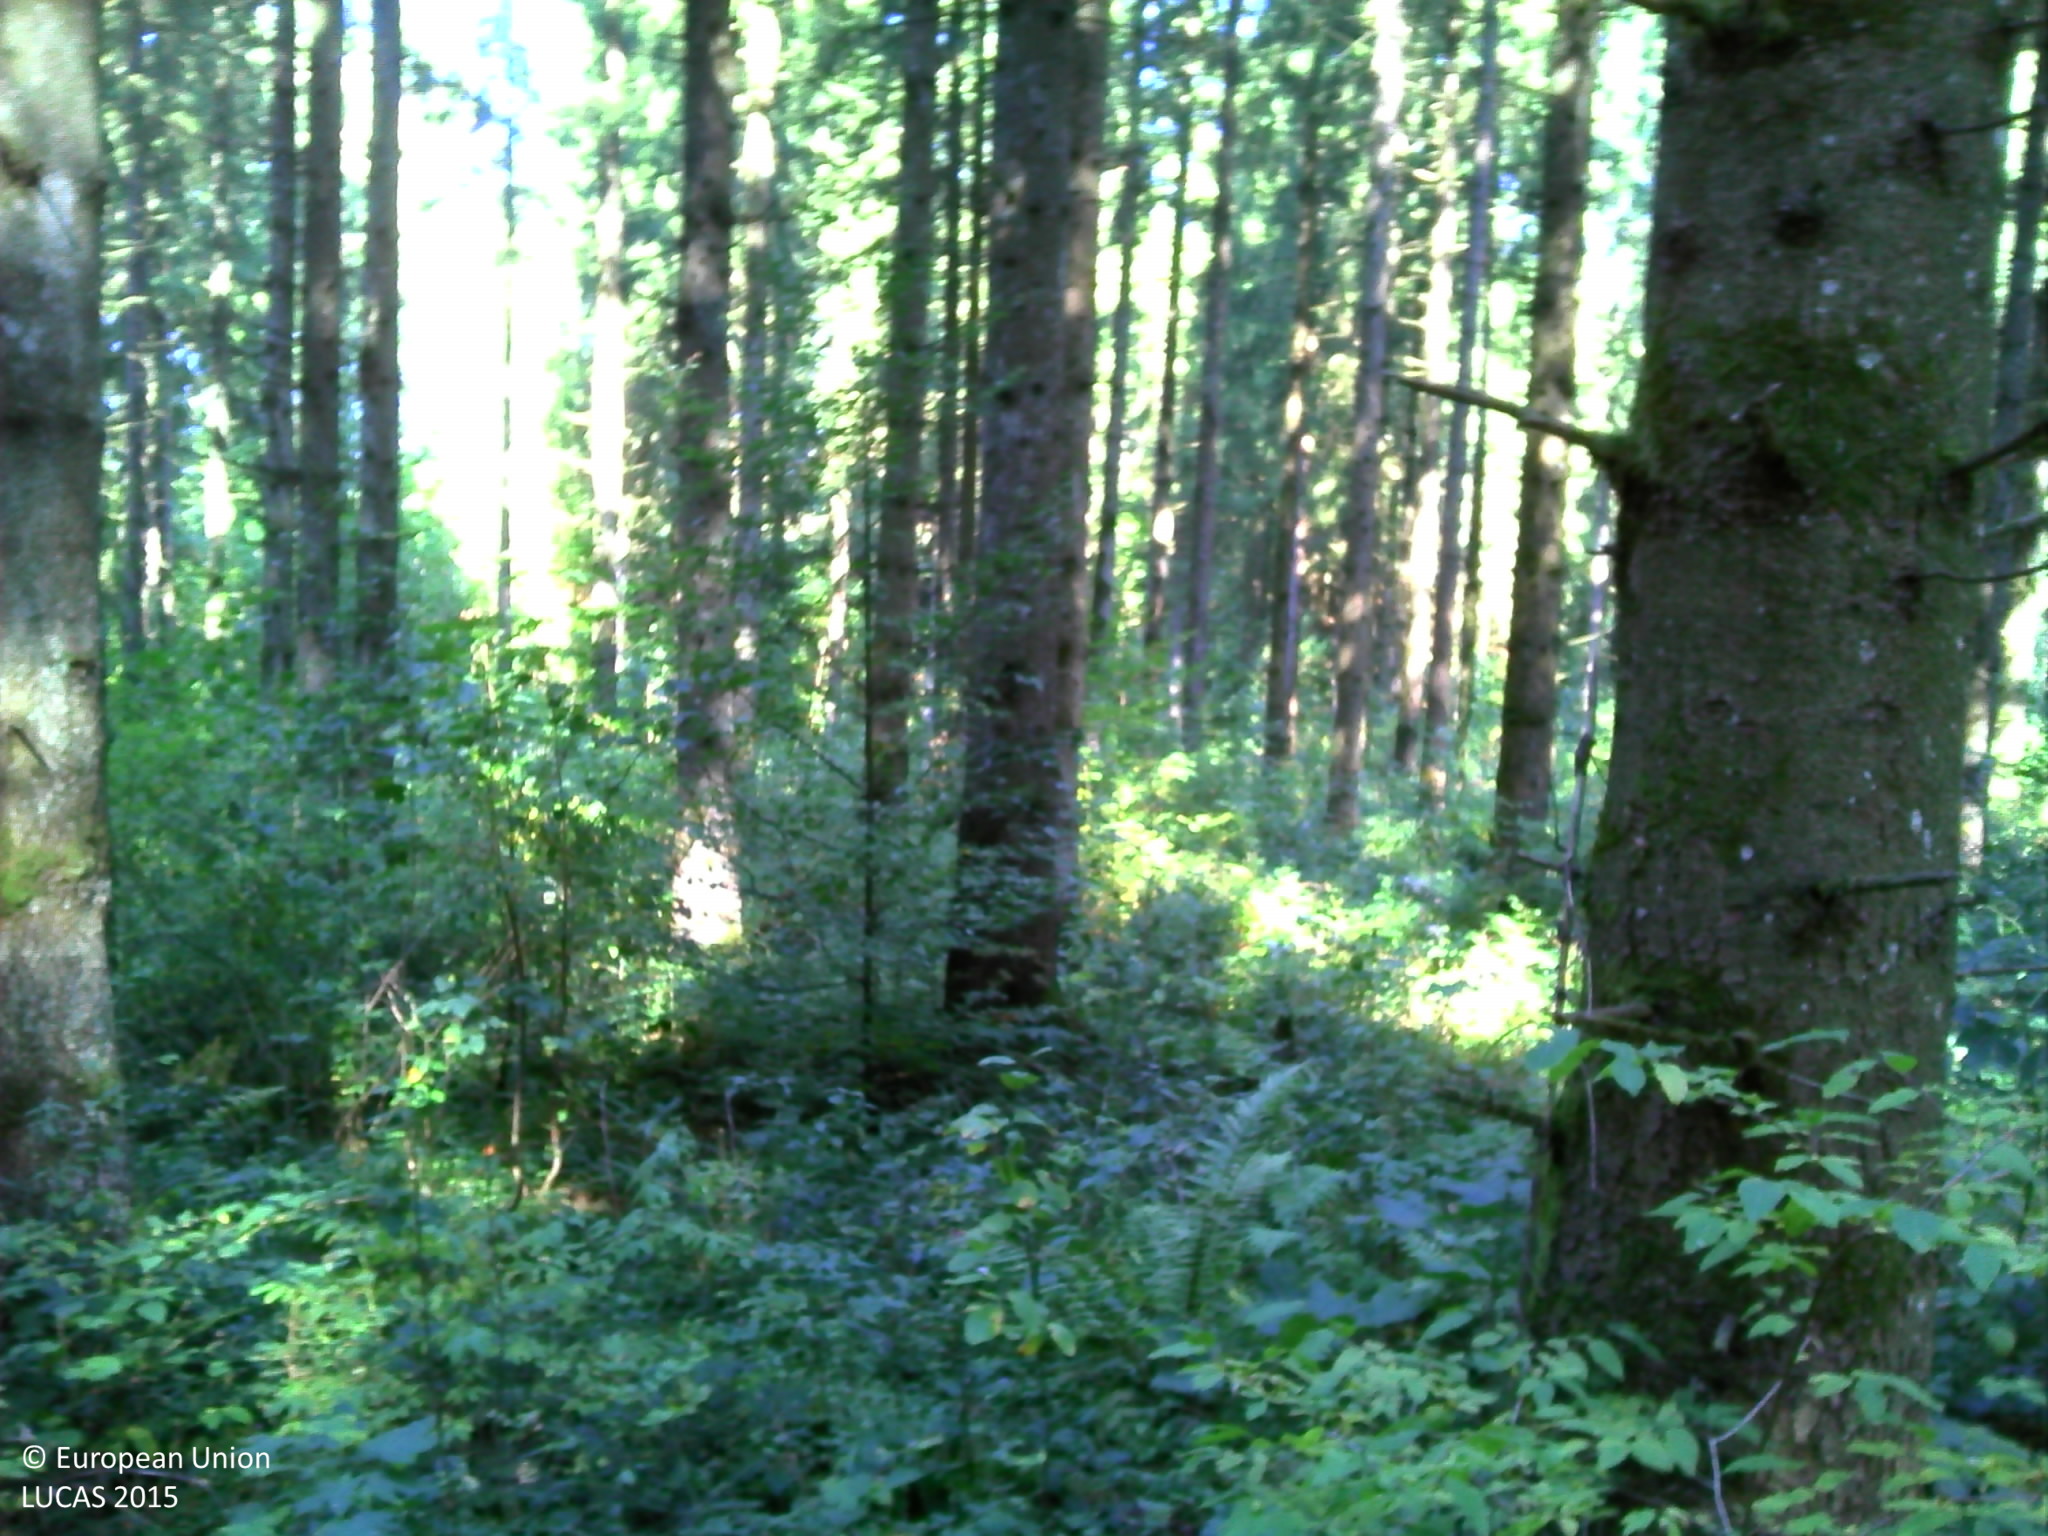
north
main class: Woodland
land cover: Spruce dominated coniferous woodland
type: exotic forest
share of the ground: > 75 %
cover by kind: coniferous forest trees 90 %, shrubs 5 %, herbaceous plants 5 %
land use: Forestry
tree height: > 5 m
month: September
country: FR
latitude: 47.1878
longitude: 6.8479
